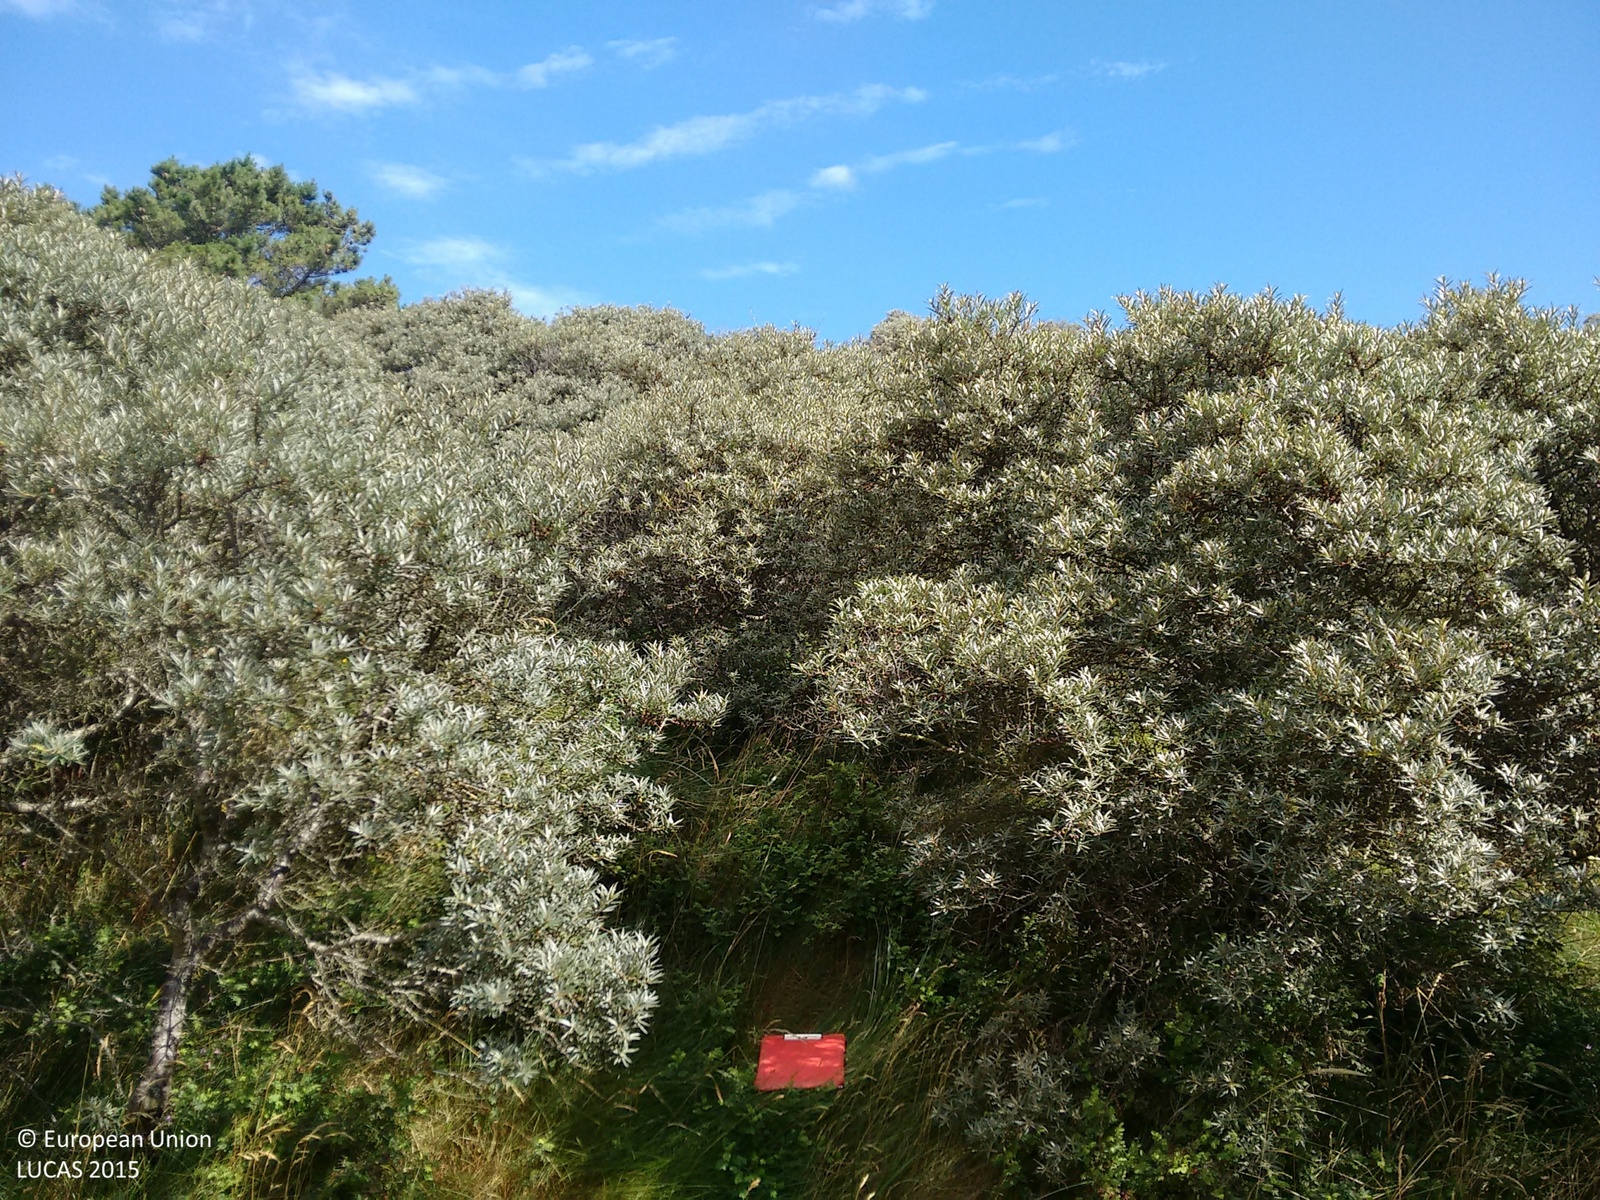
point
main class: Shrubland
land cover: Shrubland without tree cover
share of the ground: > 75 %
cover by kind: shrubs 95 %, herbaceous plants 5 %
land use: Semi-natural and natural areas not in use
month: August
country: IE
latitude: 52.7075
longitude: -6.1770
